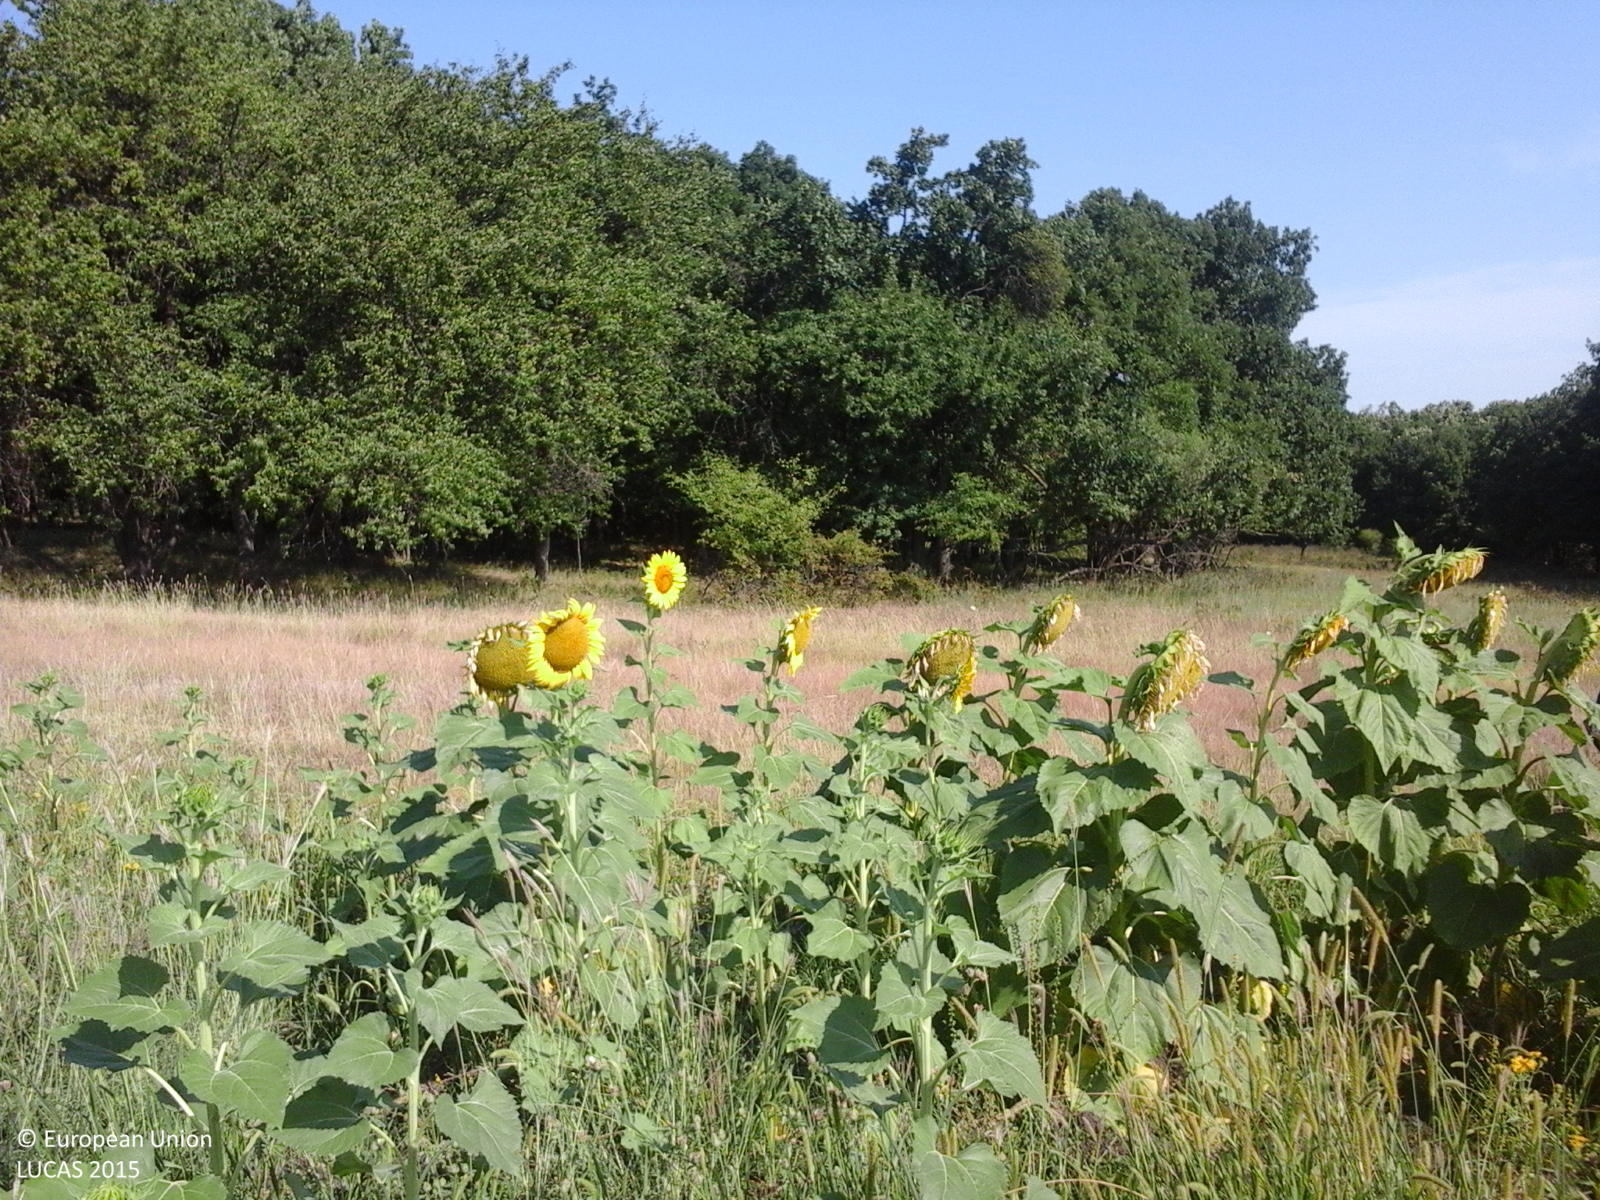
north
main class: Cropland
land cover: Sunflower
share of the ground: > 75 %
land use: Agriculture (excluding fallow land and kitchen gardens)
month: July
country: RO
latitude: 46.0393
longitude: 27.8060
